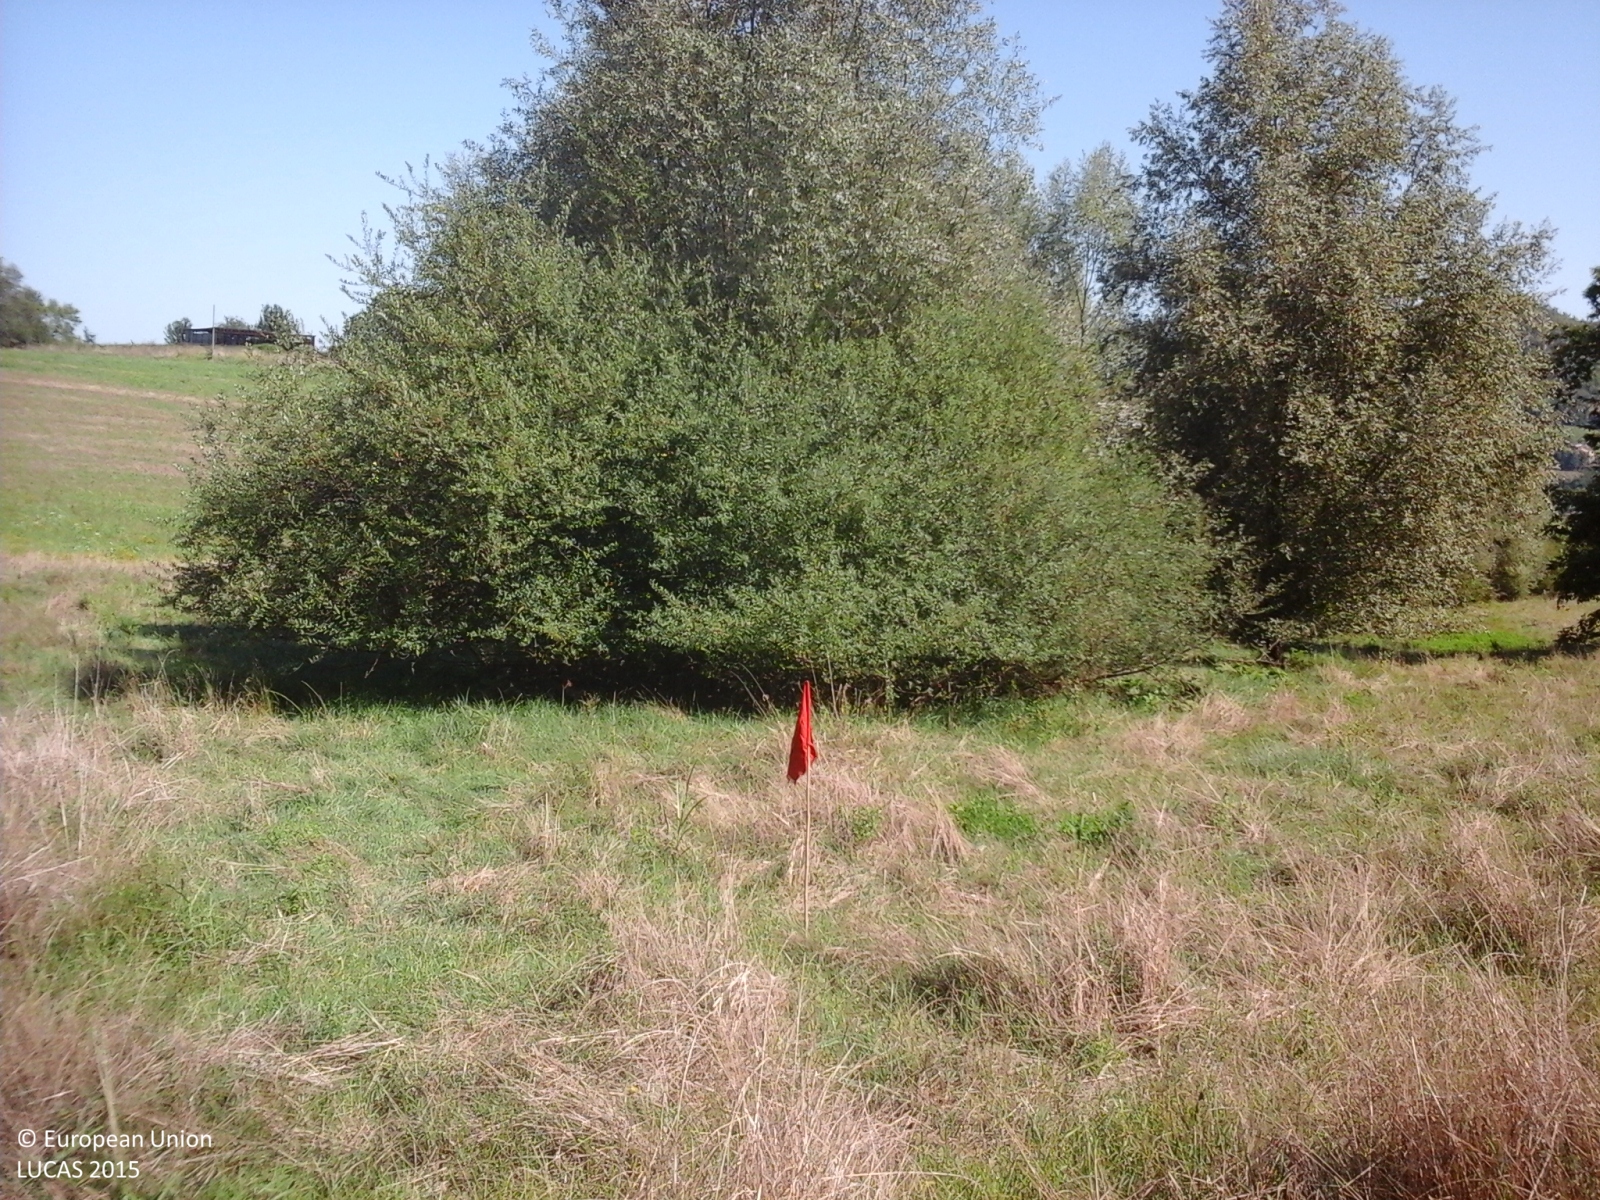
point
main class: Grassland
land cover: Grassland without tree/shrub cover
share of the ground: > 75 %
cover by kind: herbaceous plants 100 %
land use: Agriculture (excluding fallow land and kitchen gardens)
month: August
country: IT
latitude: 42.9597
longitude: 13.3617
